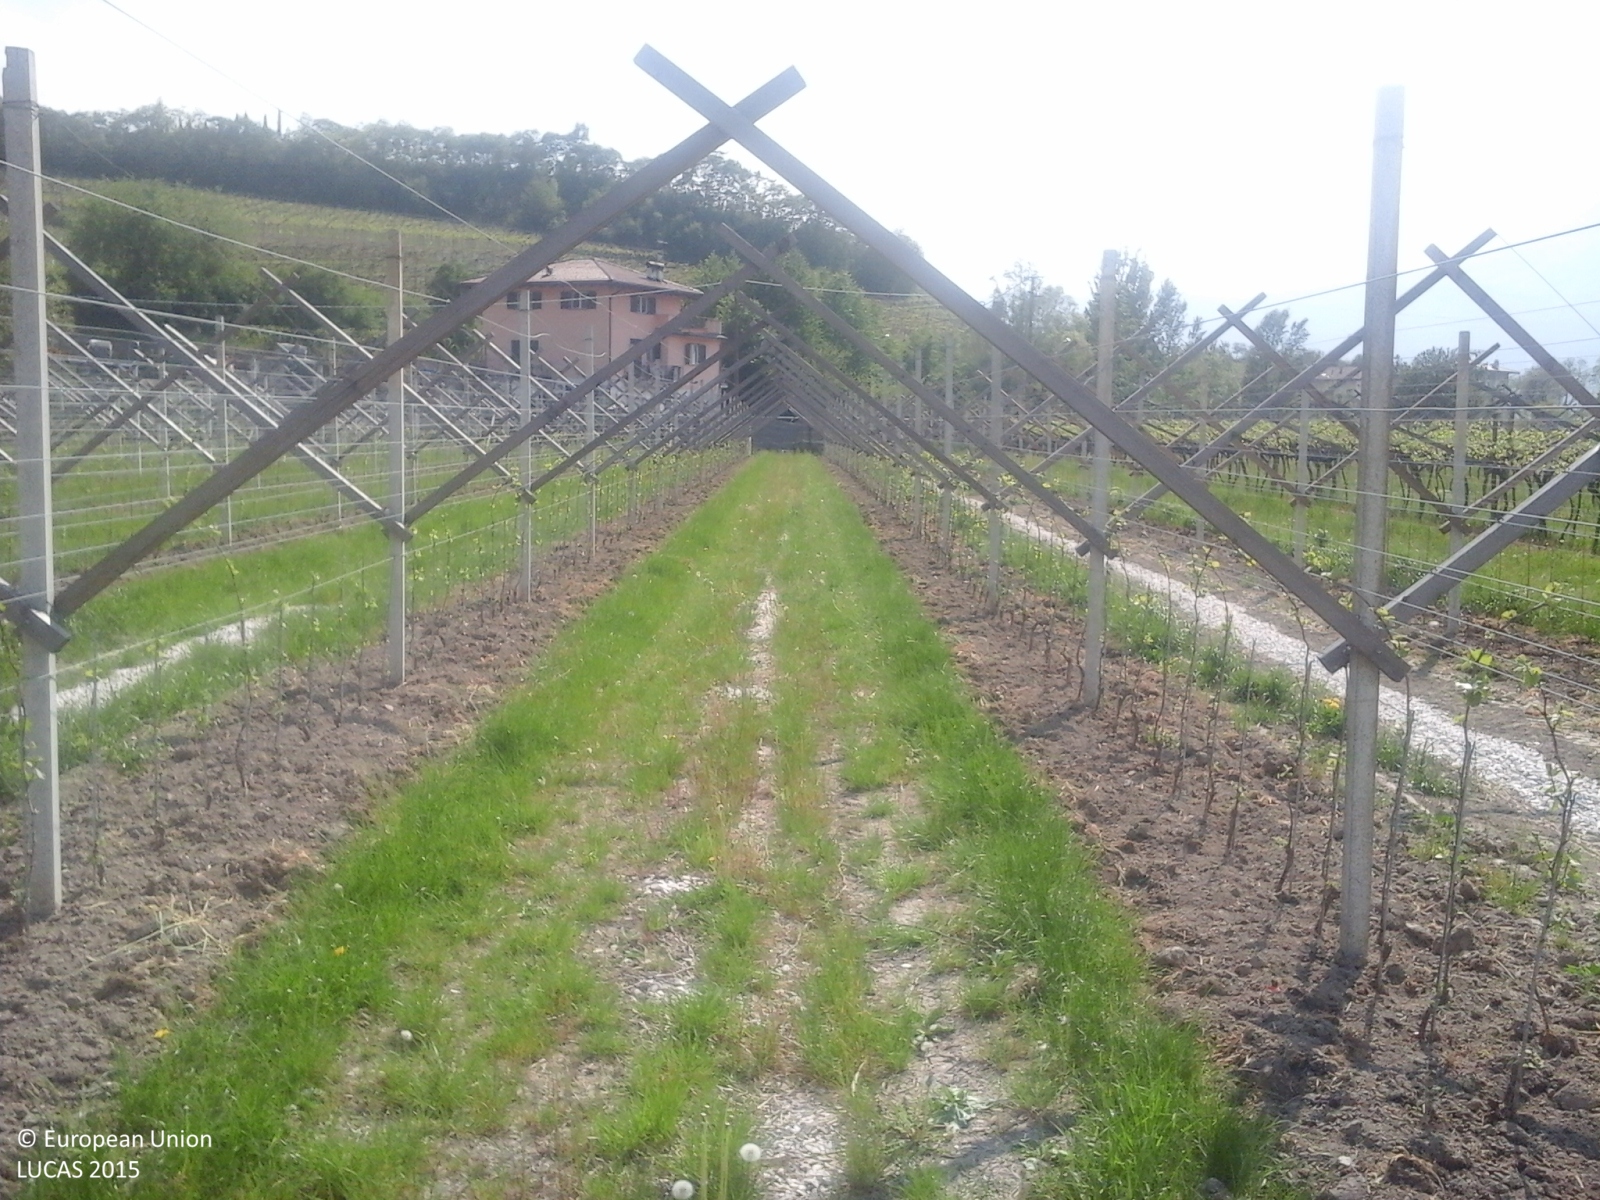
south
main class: Cropland
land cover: Vineyards
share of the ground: < 10 %
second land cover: Grassland without tree/shrub cover
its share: 25 - 50 %
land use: Agriculture (excluding fallow land and kitchen gardens)
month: April
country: IT
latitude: 46.1831
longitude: 11.1256
